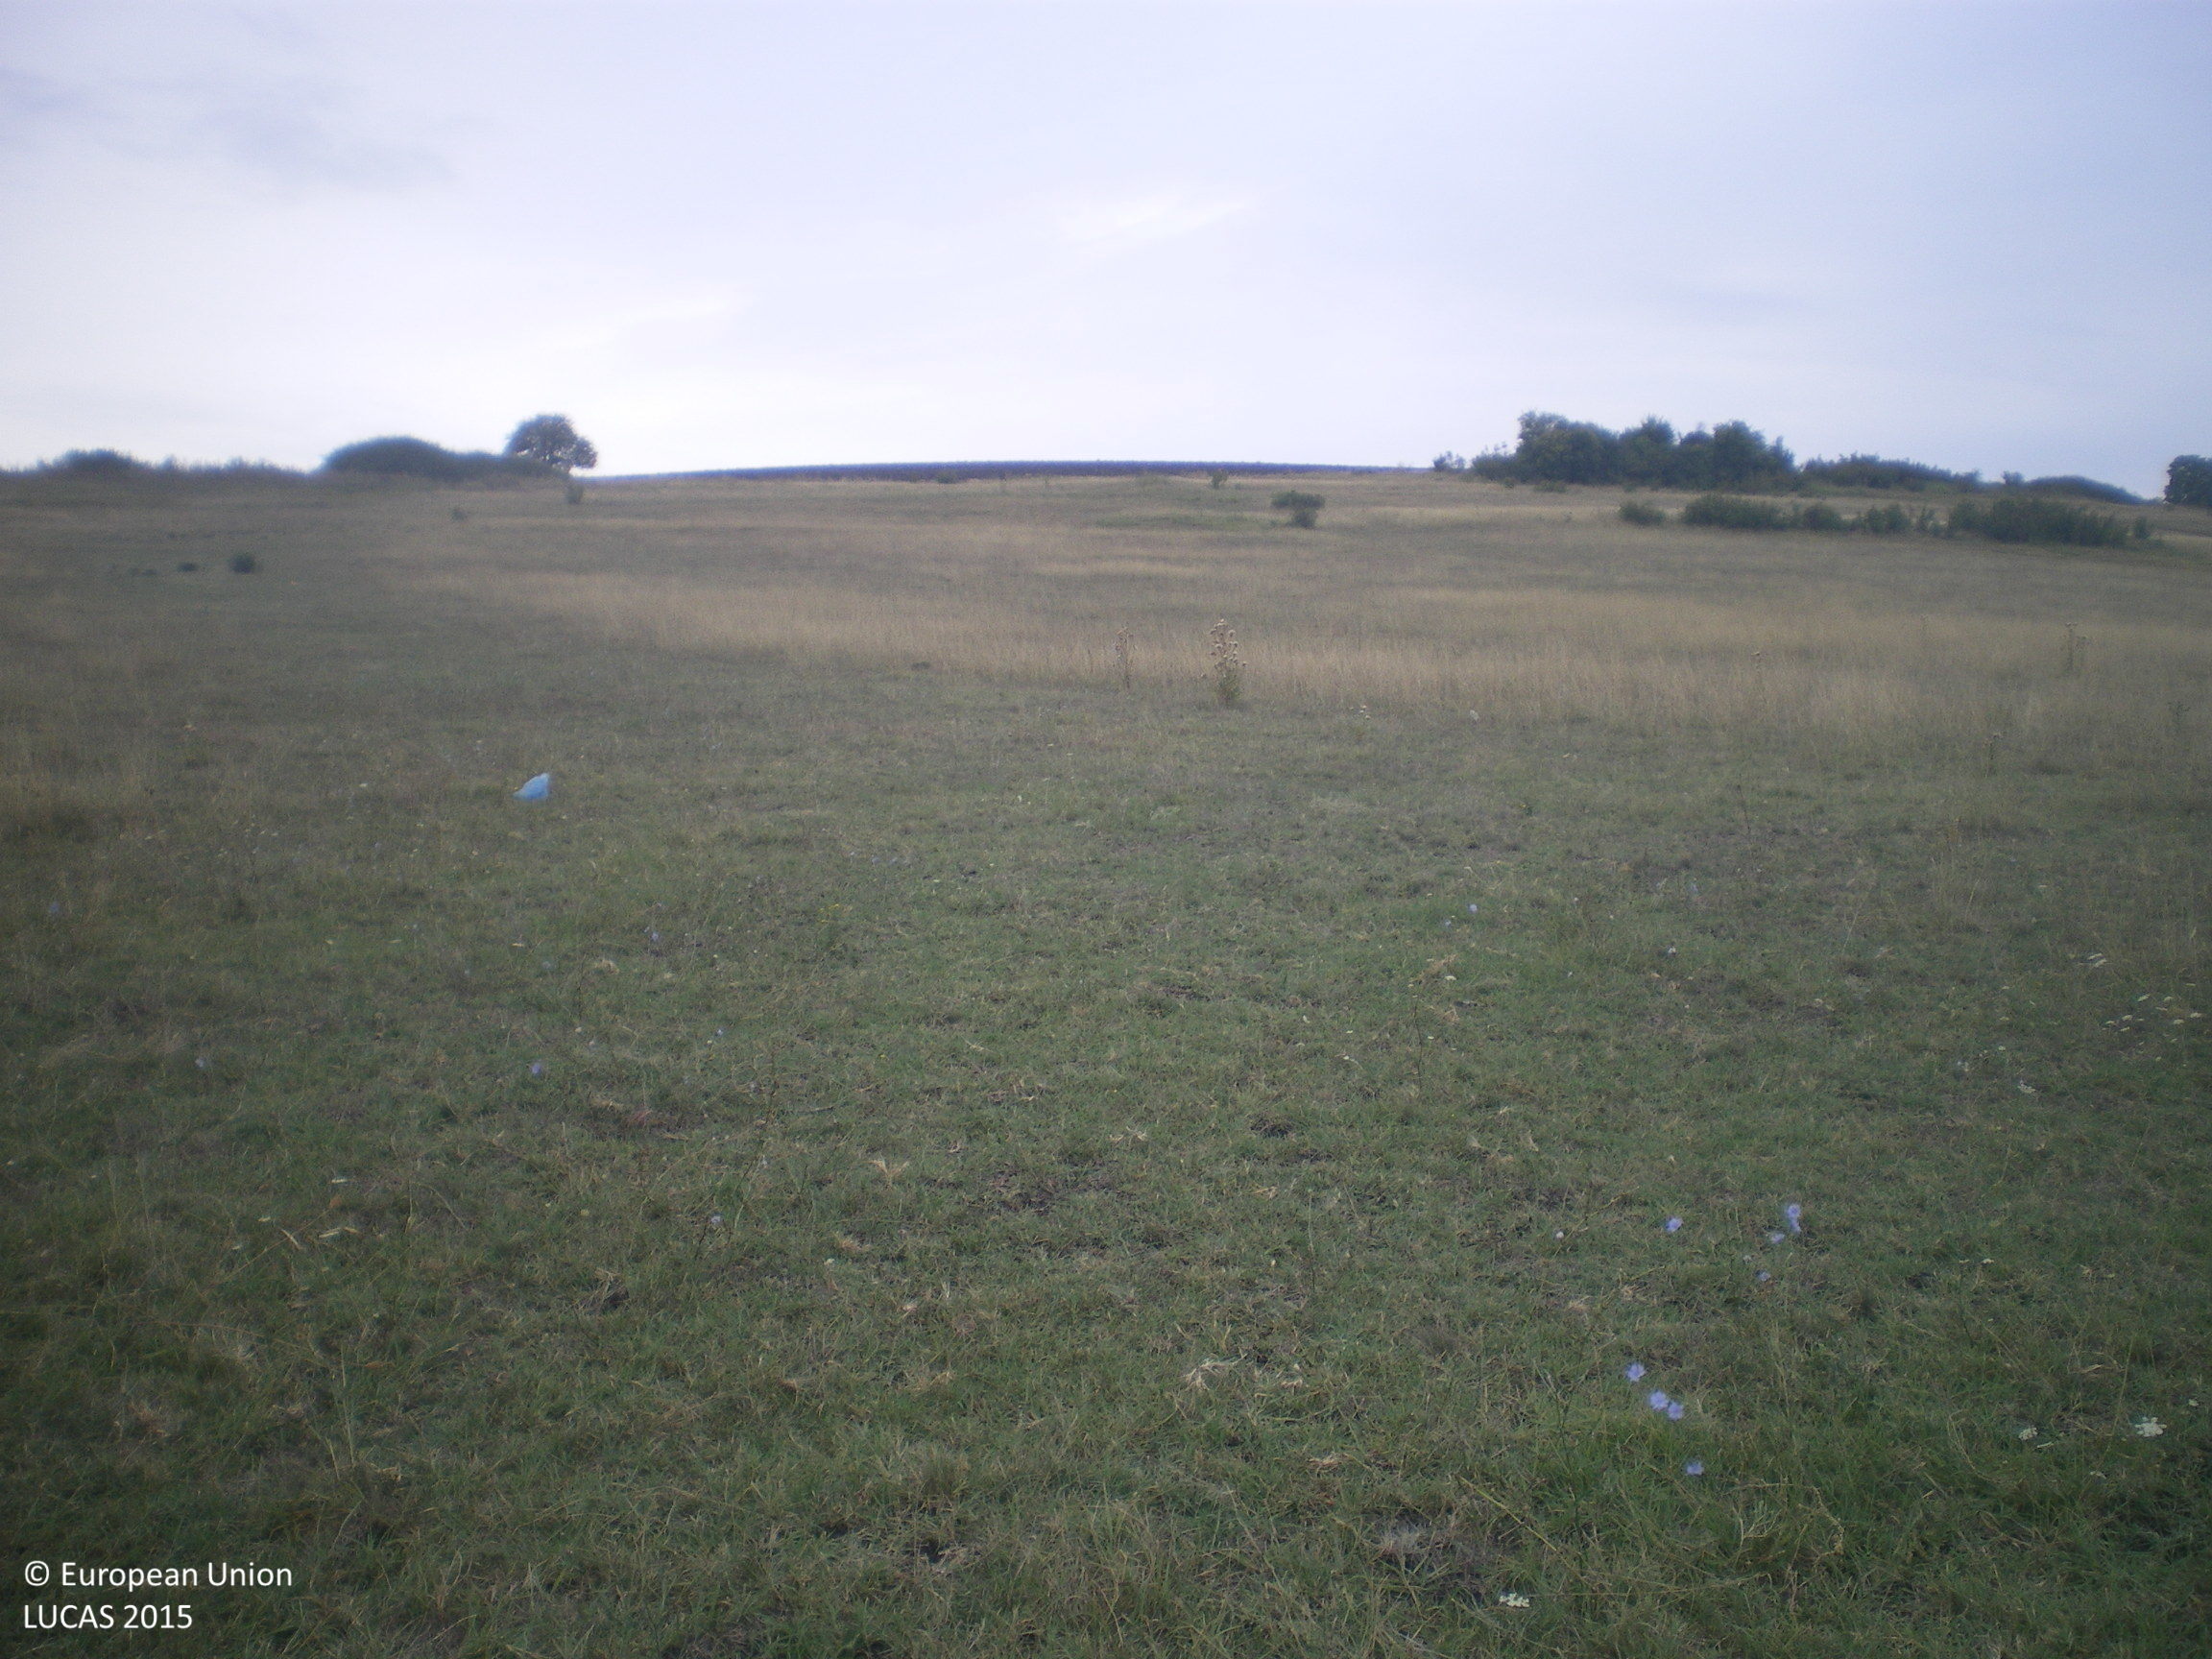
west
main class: Grassland
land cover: Grassland without tree/shrub cover
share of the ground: > 75 %
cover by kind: herbaceous plants 100 %
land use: Agriculture (excluding fallow land and kitchen gardens)
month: September
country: BG
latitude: 42.2356
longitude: 25.8885
